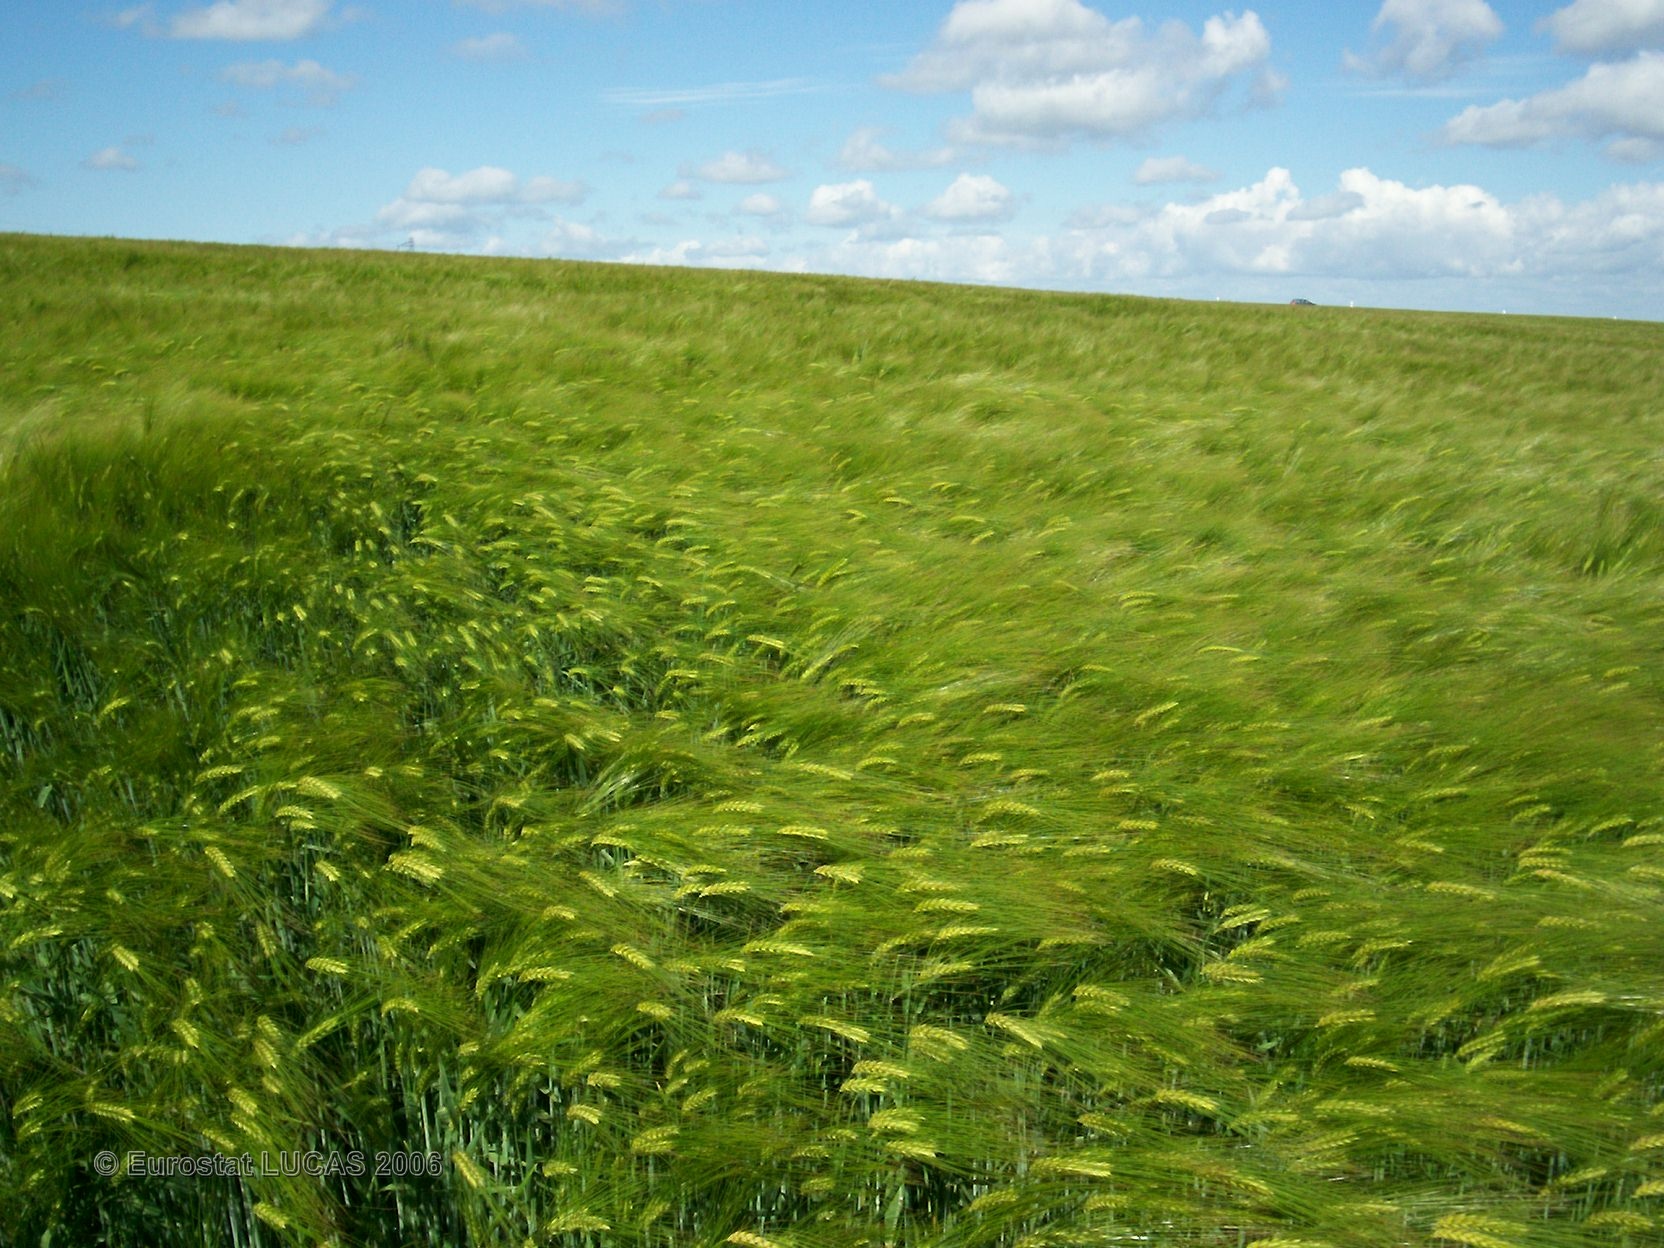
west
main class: Cropland
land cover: Barley
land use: Agriculture (excluding fallow land and kitchen gardens)
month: May
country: FR
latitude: 48.1777
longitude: 4.5242
